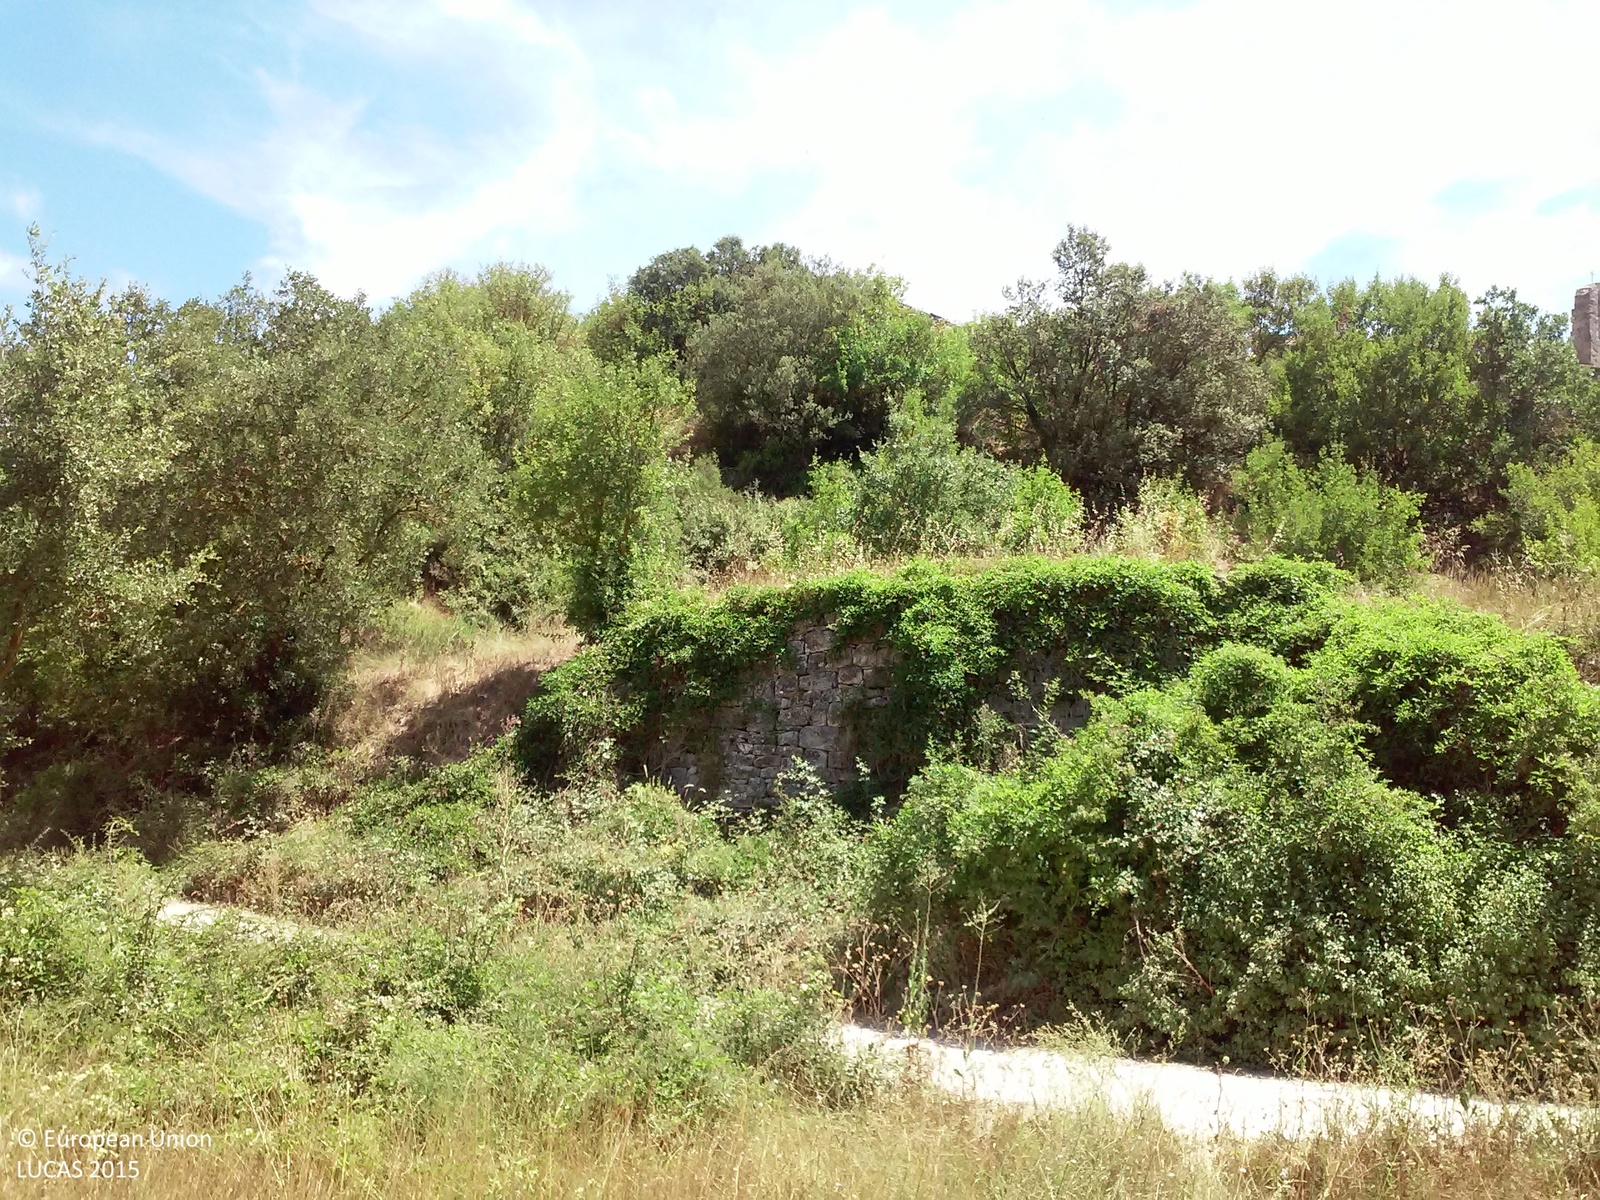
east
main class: Woodland
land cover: Broadleaved woodland
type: broadleaved evergreen forest
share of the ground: 50 - 75 %
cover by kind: herbaceous plants 40 %, broadleaved forest trees 25 %, shrubs 25 %, lichens and mosses 10 %
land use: Semi-natural and natural areas not in use
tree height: < 5 m
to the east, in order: Broadleaved woodland; Grassland without tree/shrub cover; Shruby margins; Paved roads, cycling and walking lanes; Shrubland with sparse tree cover; Dry stone walls; Shruby margins; Tracks; Dry stone walls; Shrubland with sparse tree cover; Artificial constructions in urban areas; Shrubland with sparse tree cover; Dry stone walls; Tracks; Broadleaved woodland; Dry stone walls; Other fresh vegetables; Groves; Tomatoes; Single bushes/trees; Shrubland without tree cover; Tracks; Shrubland without tree cover; Broadleaved woodland; Tracks; Broadleaved woodland
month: July
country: ES
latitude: 41.5284
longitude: 1.2300
